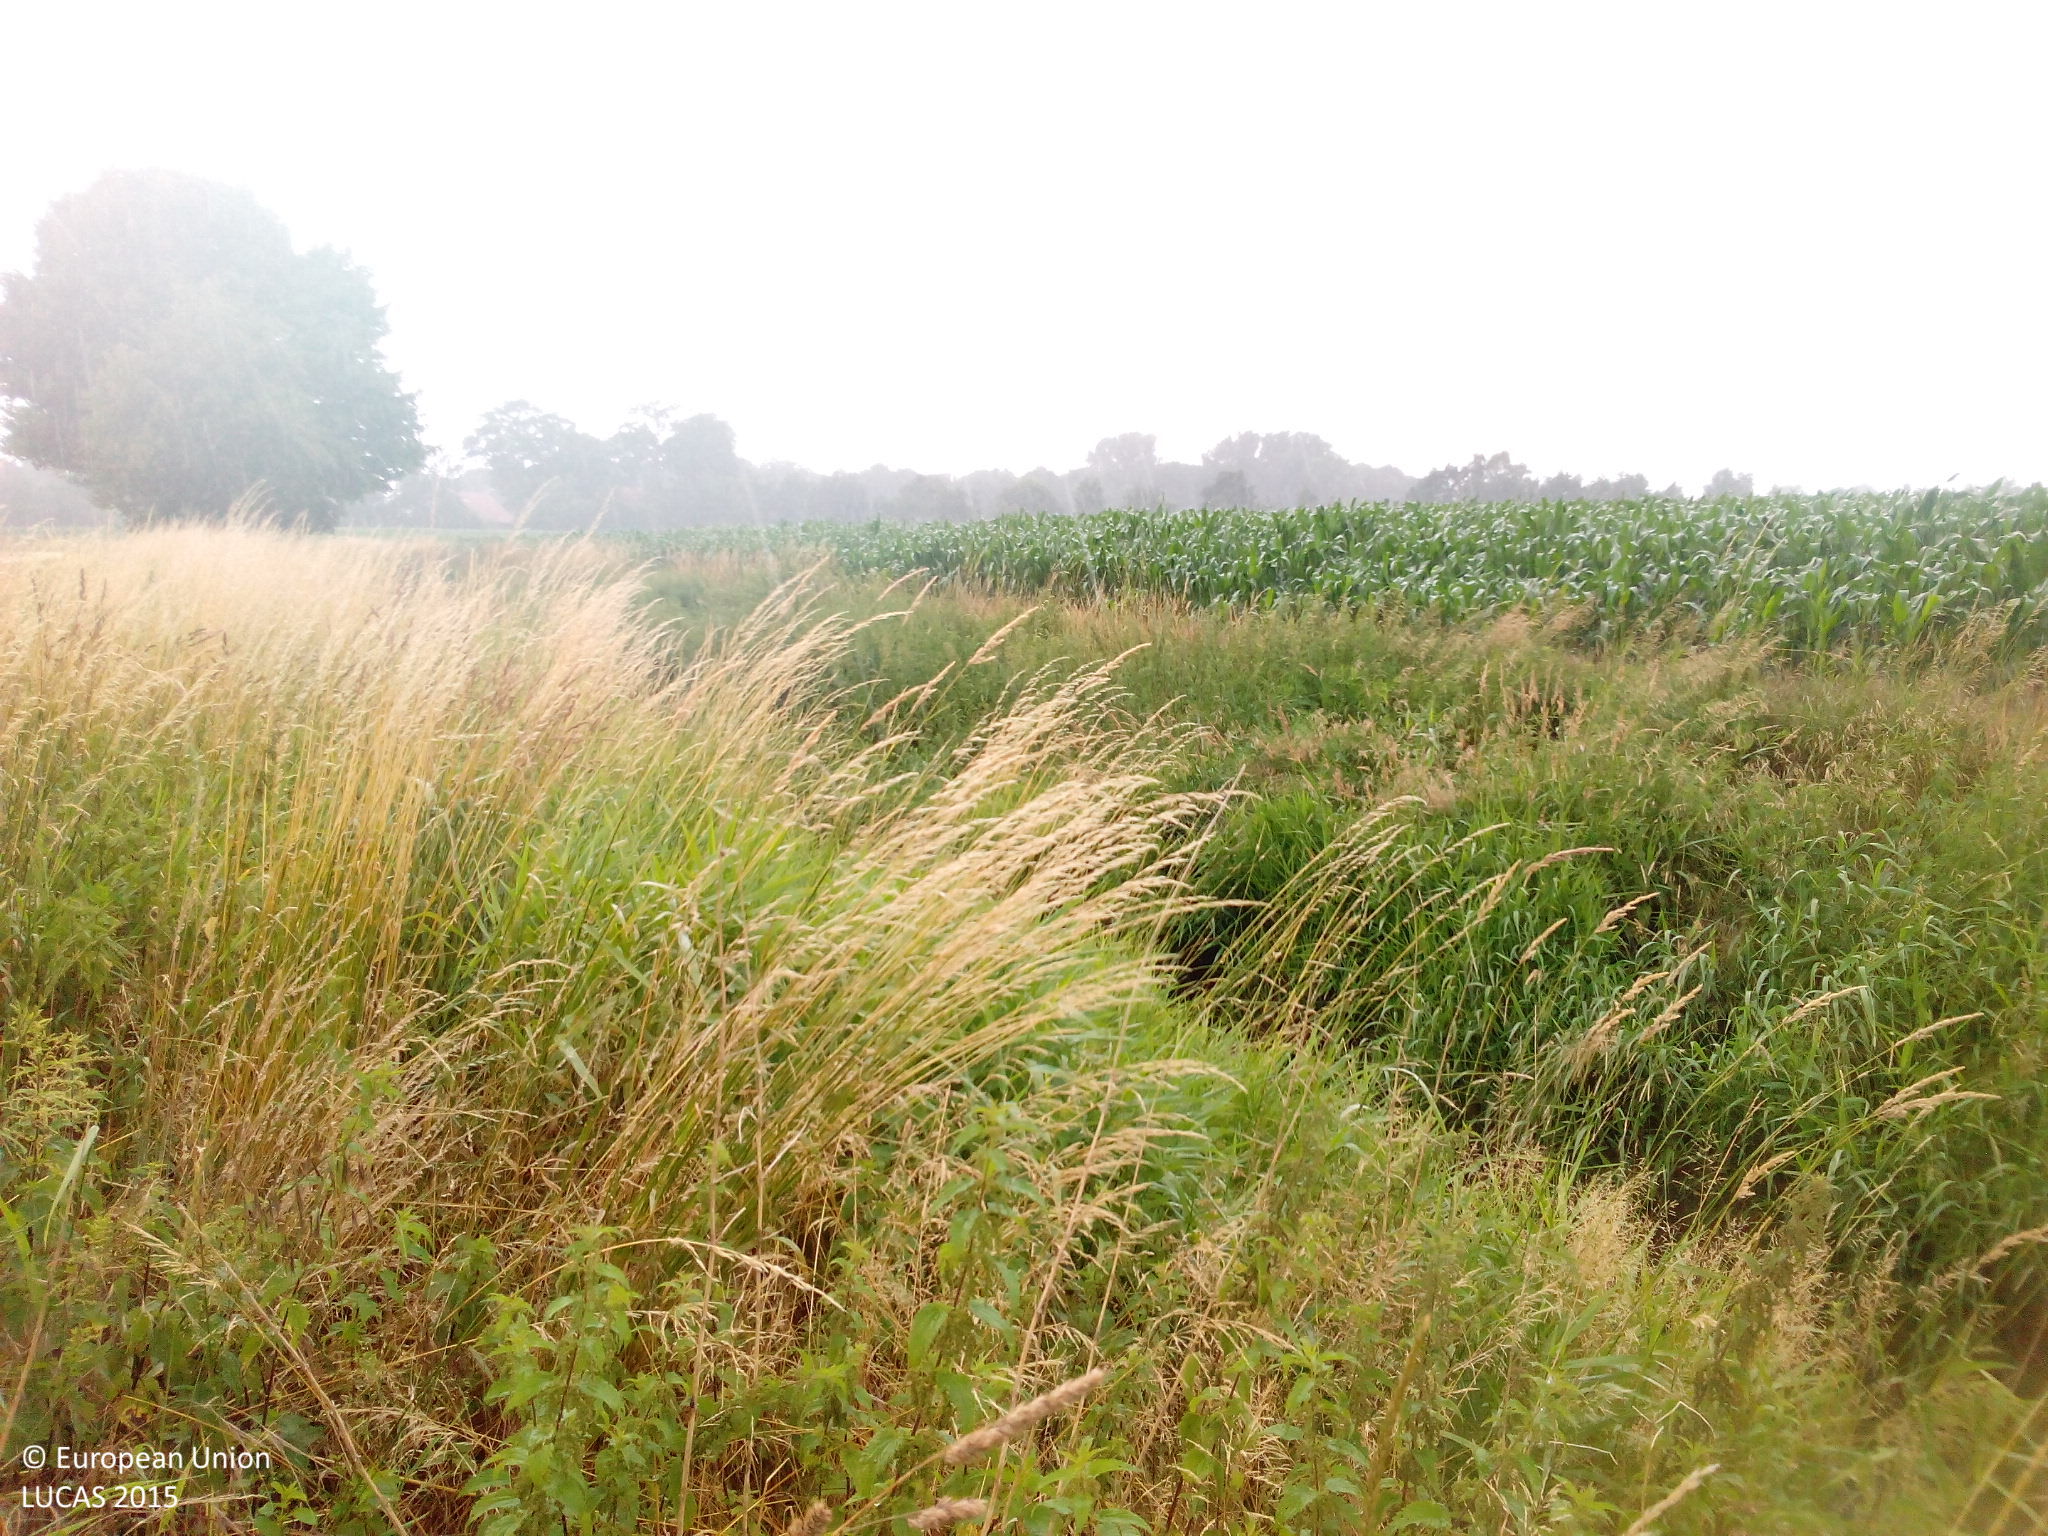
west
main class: Cropland
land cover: Maize
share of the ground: > 75 %
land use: Agriculture (excluding fallow land and kitchen gardens)
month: July
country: DE
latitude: 51.7935
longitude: 8.5650
